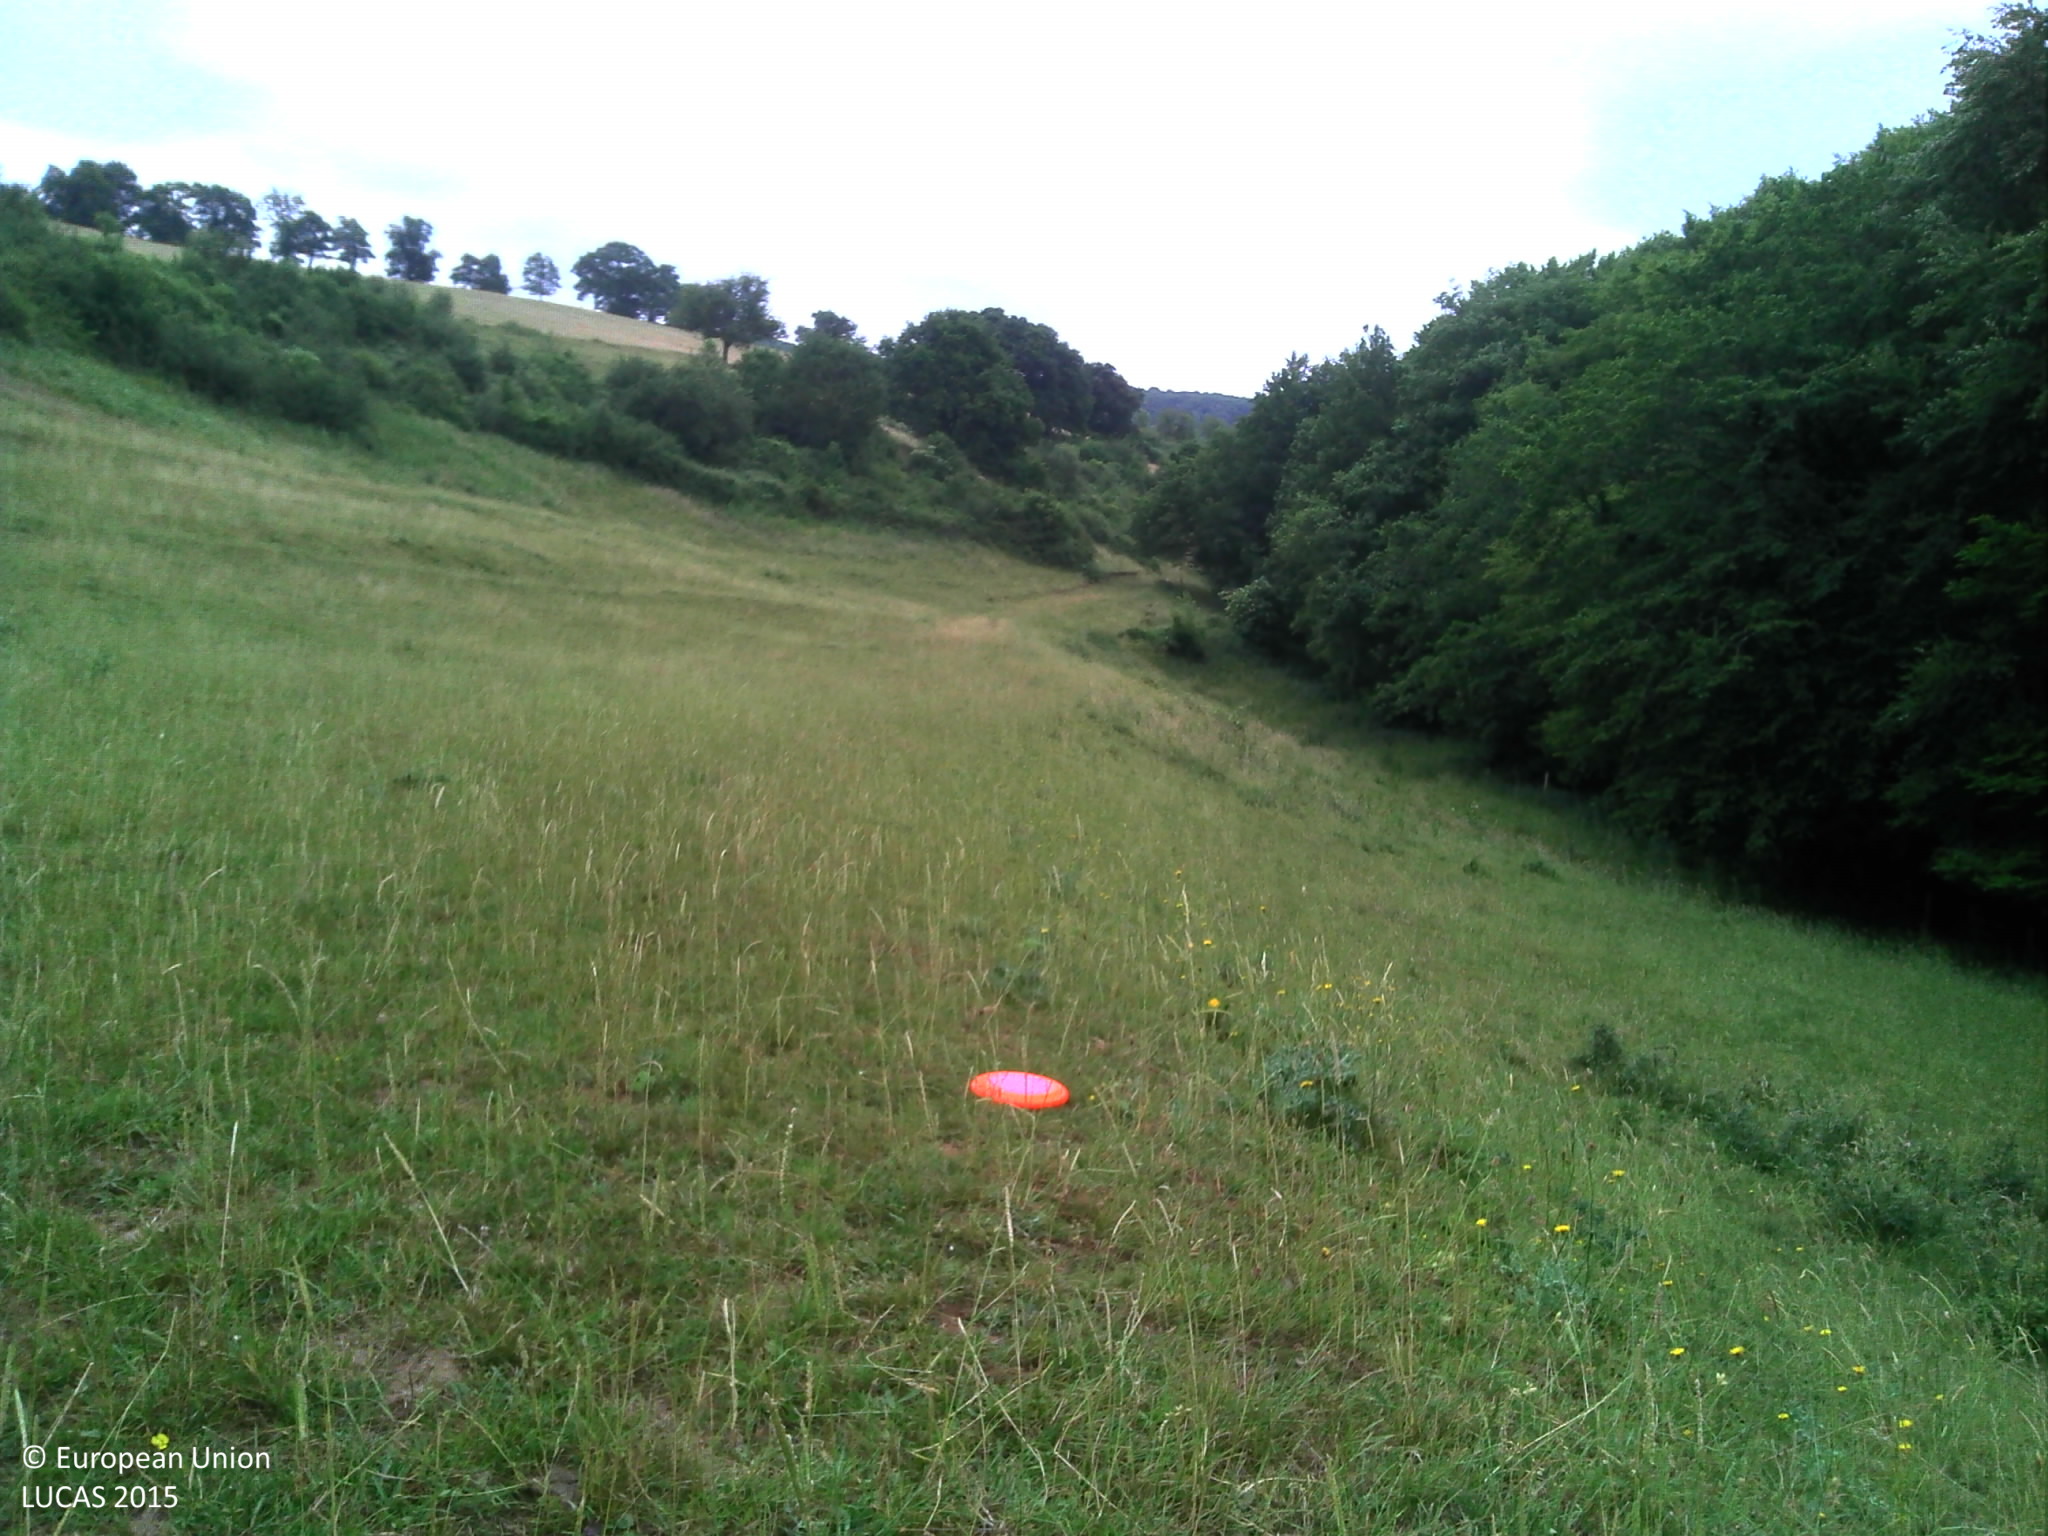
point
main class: Grassland
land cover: Grassland without tree/shrub cover
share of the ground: > 75 %
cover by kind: herbaceous plants 100 %
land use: Agriculture (excluding fallow land and kitchen gardens)
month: June
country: FR
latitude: 46.5303
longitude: 4.7737
